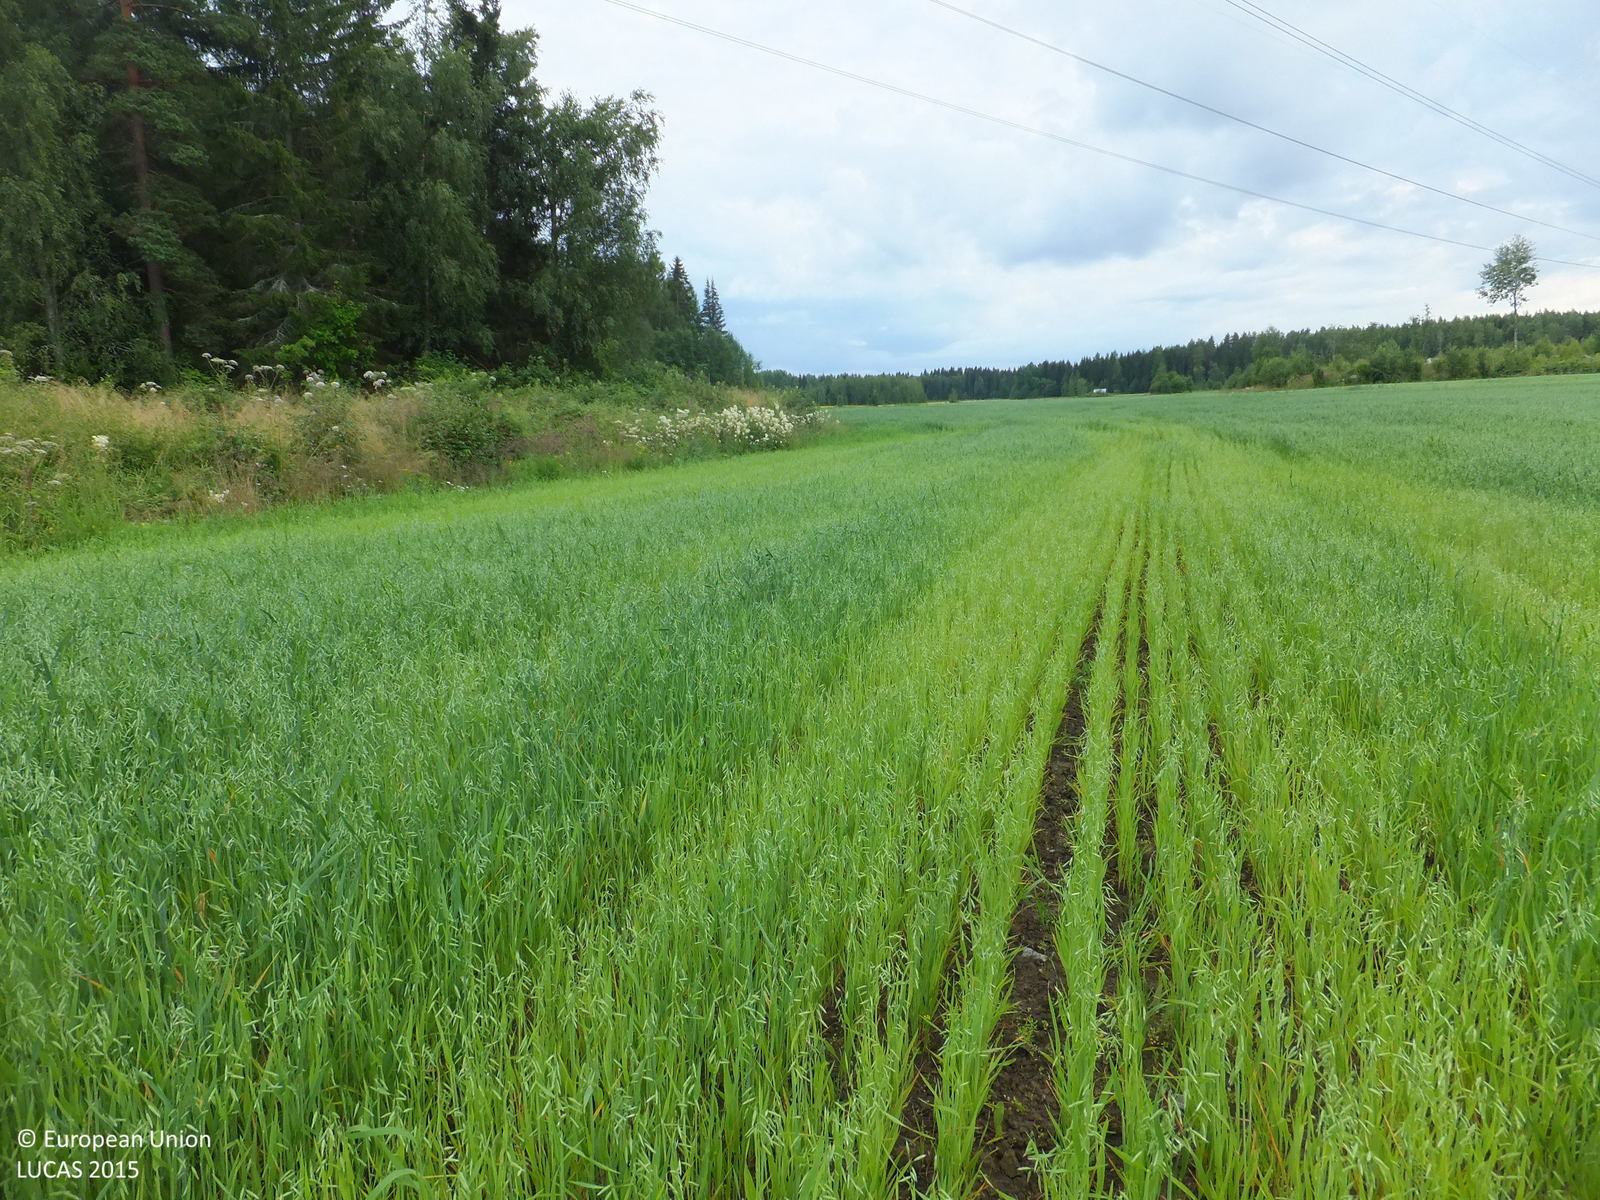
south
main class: Artificial land
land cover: Other artificial areas
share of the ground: > 75 %
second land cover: Oats
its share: > 75 %
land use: Electricity, gas and thermal power distribution
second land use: Agriculture (excluding fallow land and kitchen gardens)
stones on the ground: < 10 %
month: July
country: FI
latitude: 63.0709
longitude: 21.8986
